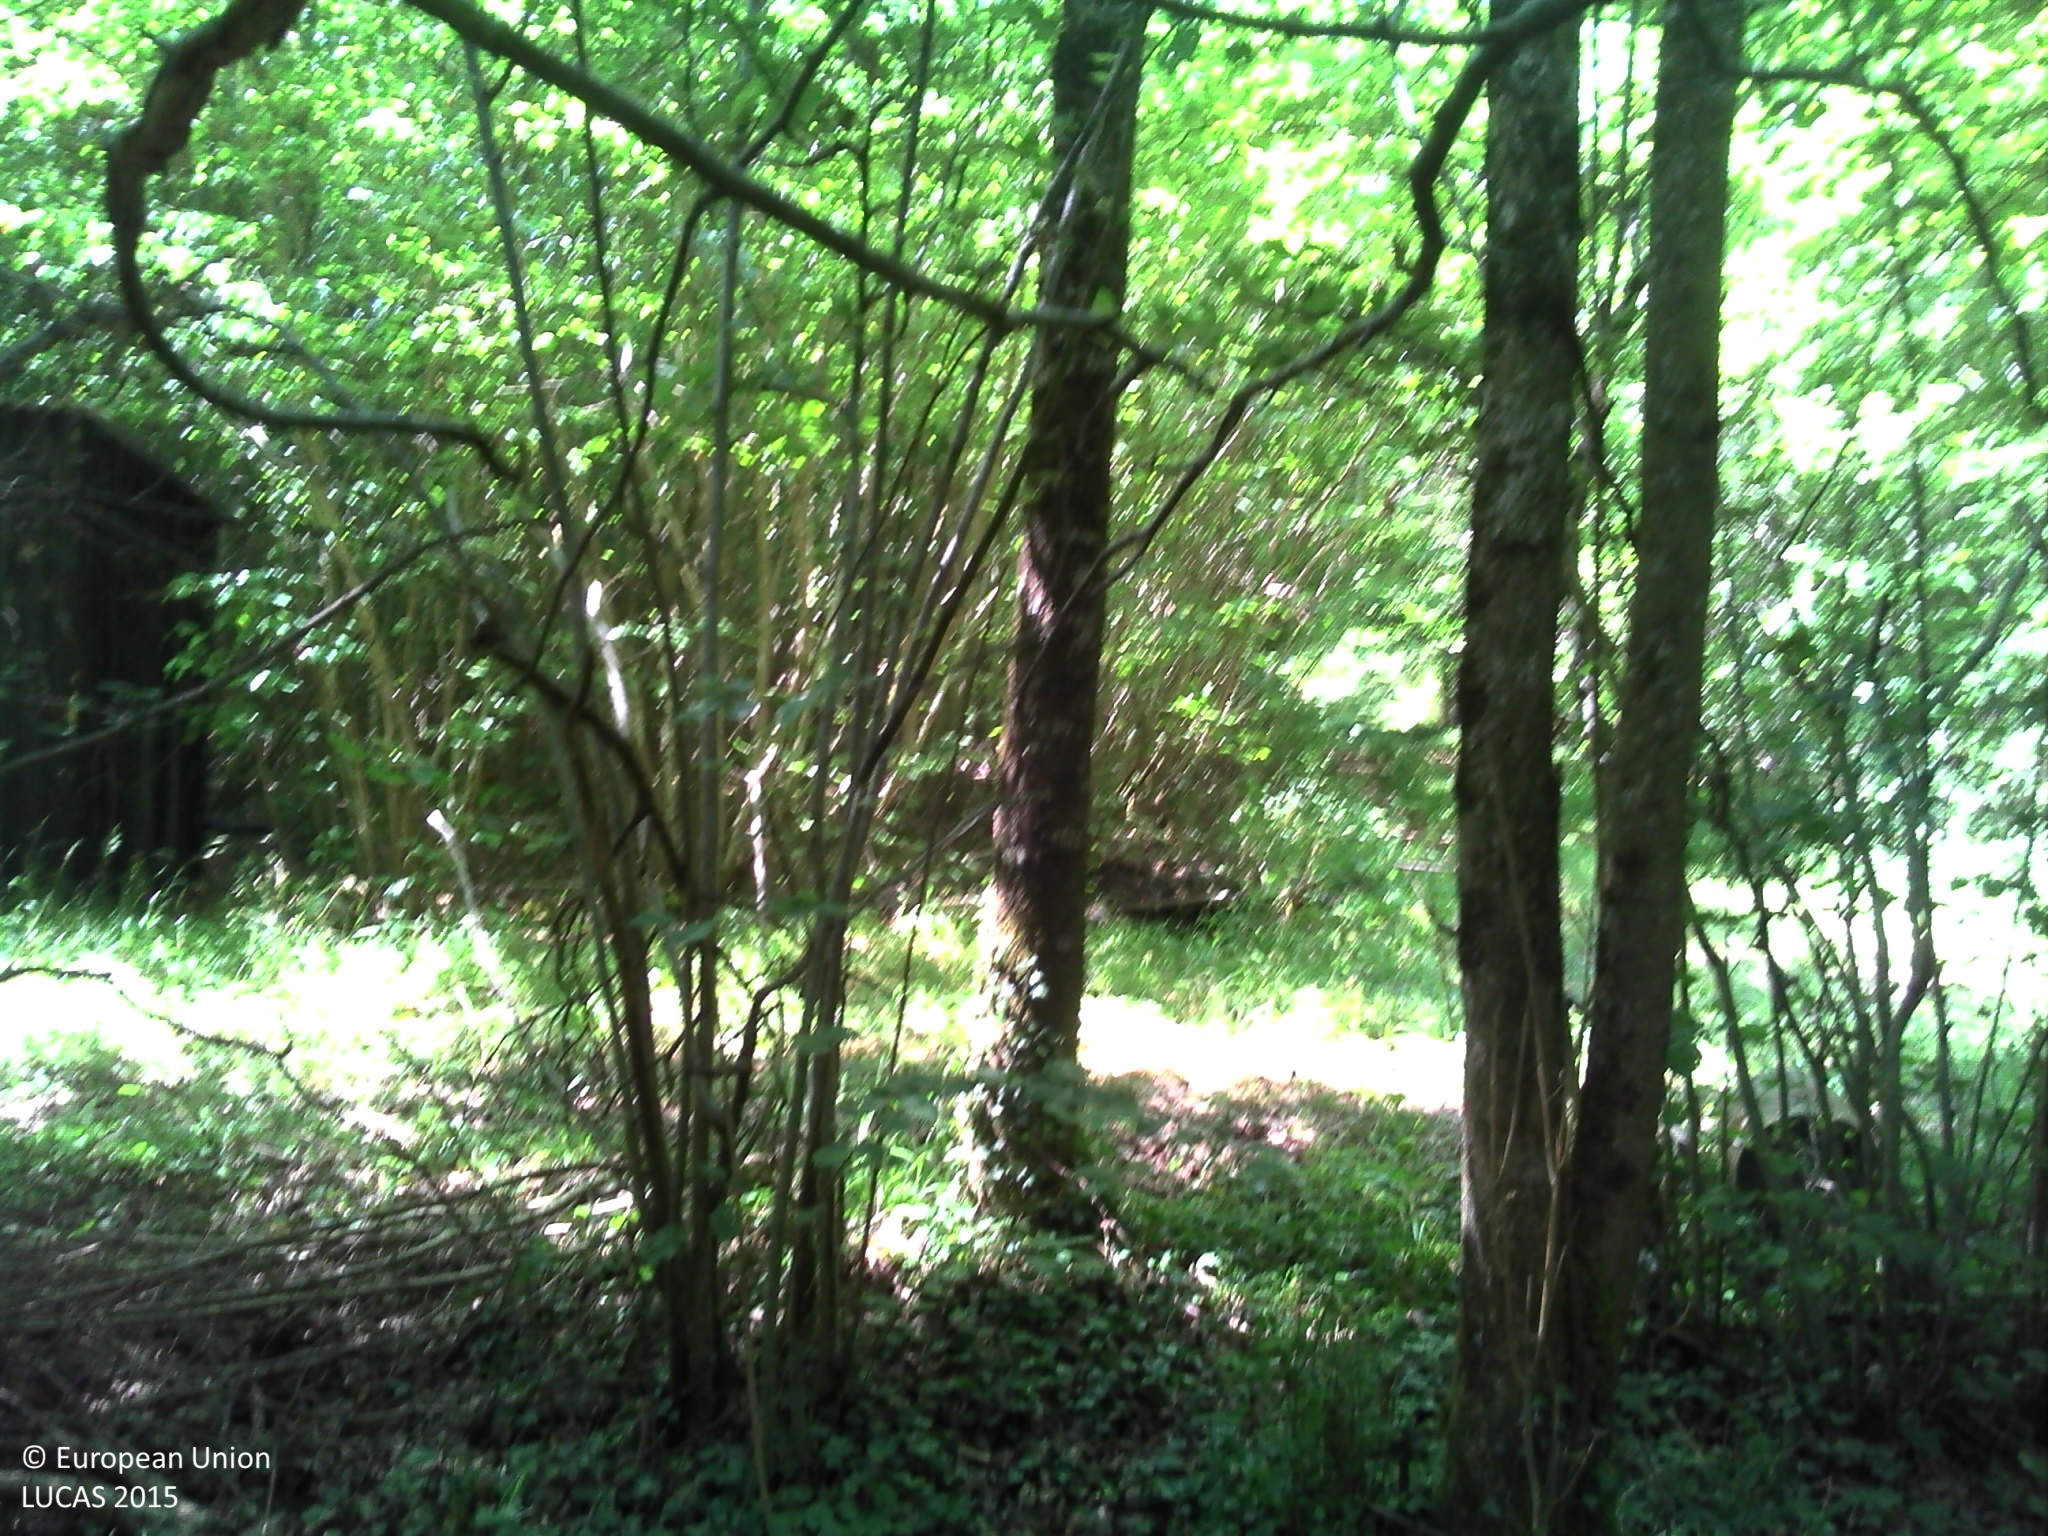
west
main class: Woodland
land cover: Broadleaved woodland
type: mesophytic deciduous forest
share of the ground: > 75 %
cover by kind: broadleaved forest trees 100 %
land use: Forestry
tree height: > 5 m
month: July
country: FR
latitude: 48.0039
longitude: 2.4979
